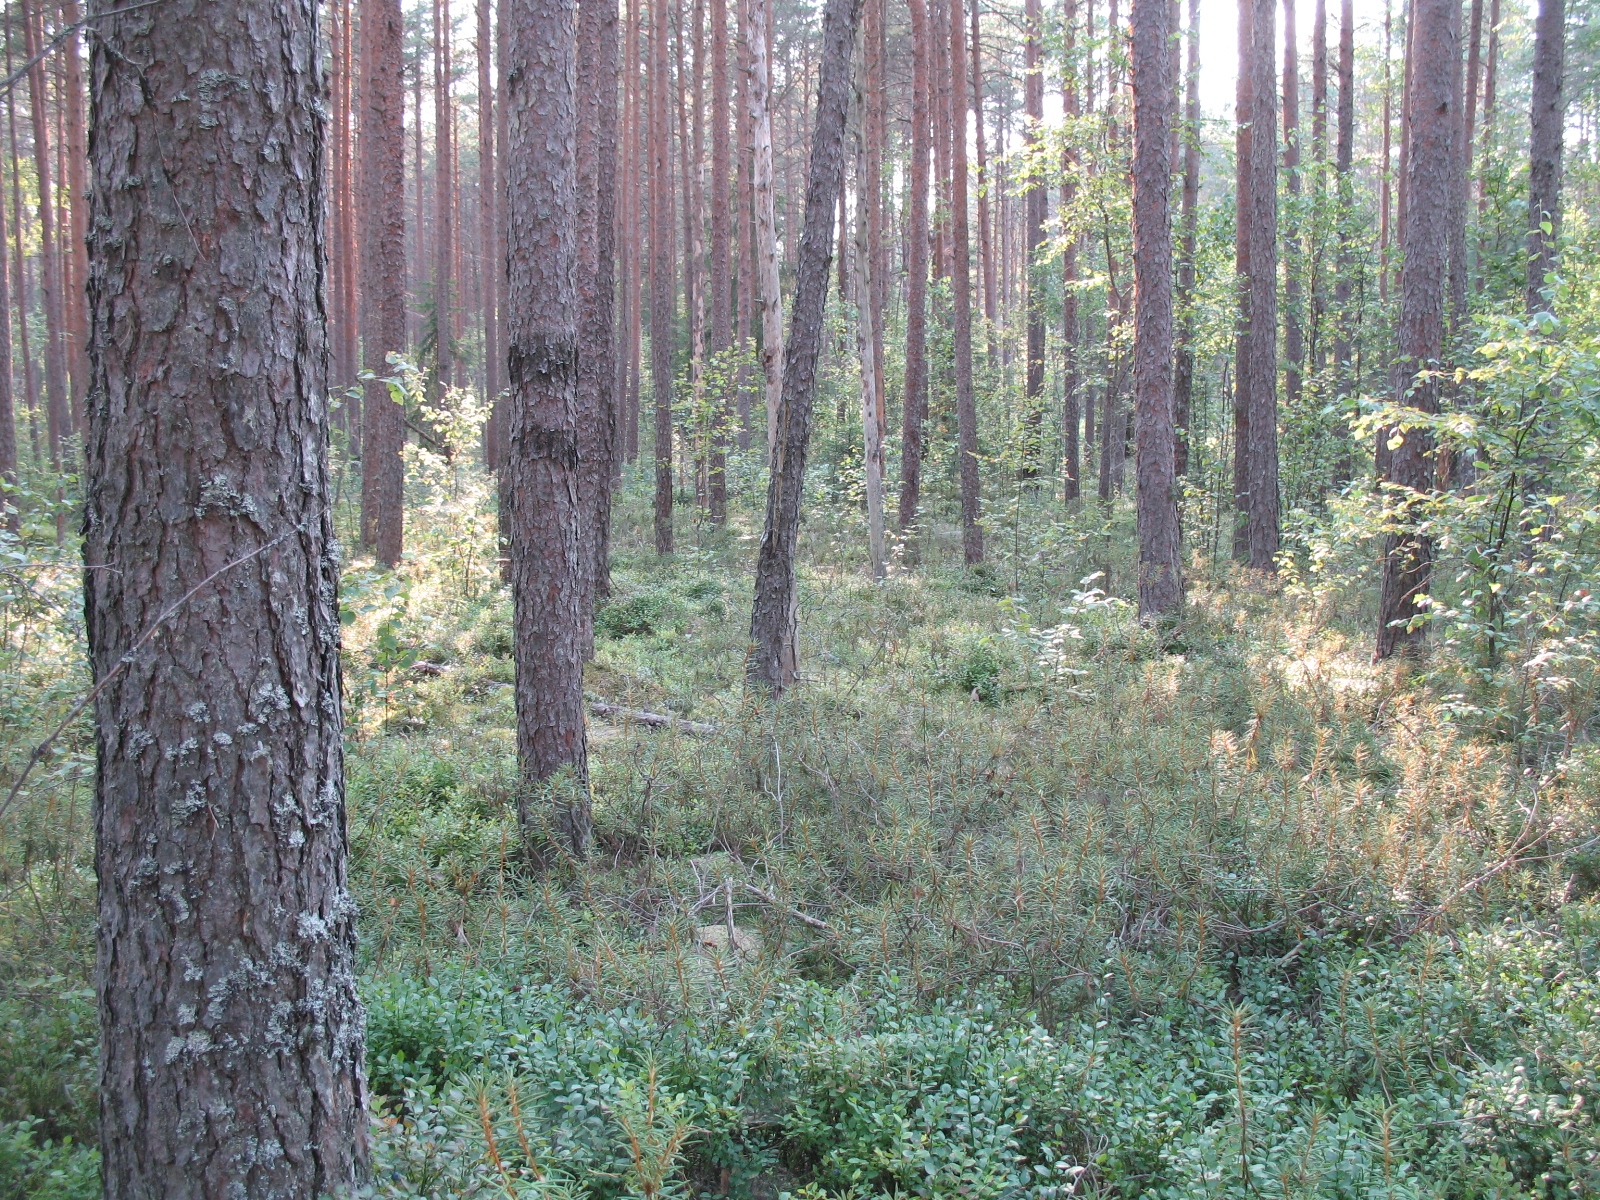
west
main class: Woodland
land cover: Pine dominated coniferous woodland
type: hemiboreal forest and nemoral coniferous forest and mixed broadleaved-coniferous forest
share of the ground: 50 - 75 %
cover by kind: coniferous forest trees 60 %, herbaceous plants 20 %, lichens and mosses 20 %
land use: Forestry
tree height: > 5 m
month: August
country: LV
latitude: 56.4370
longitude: 25.4455
